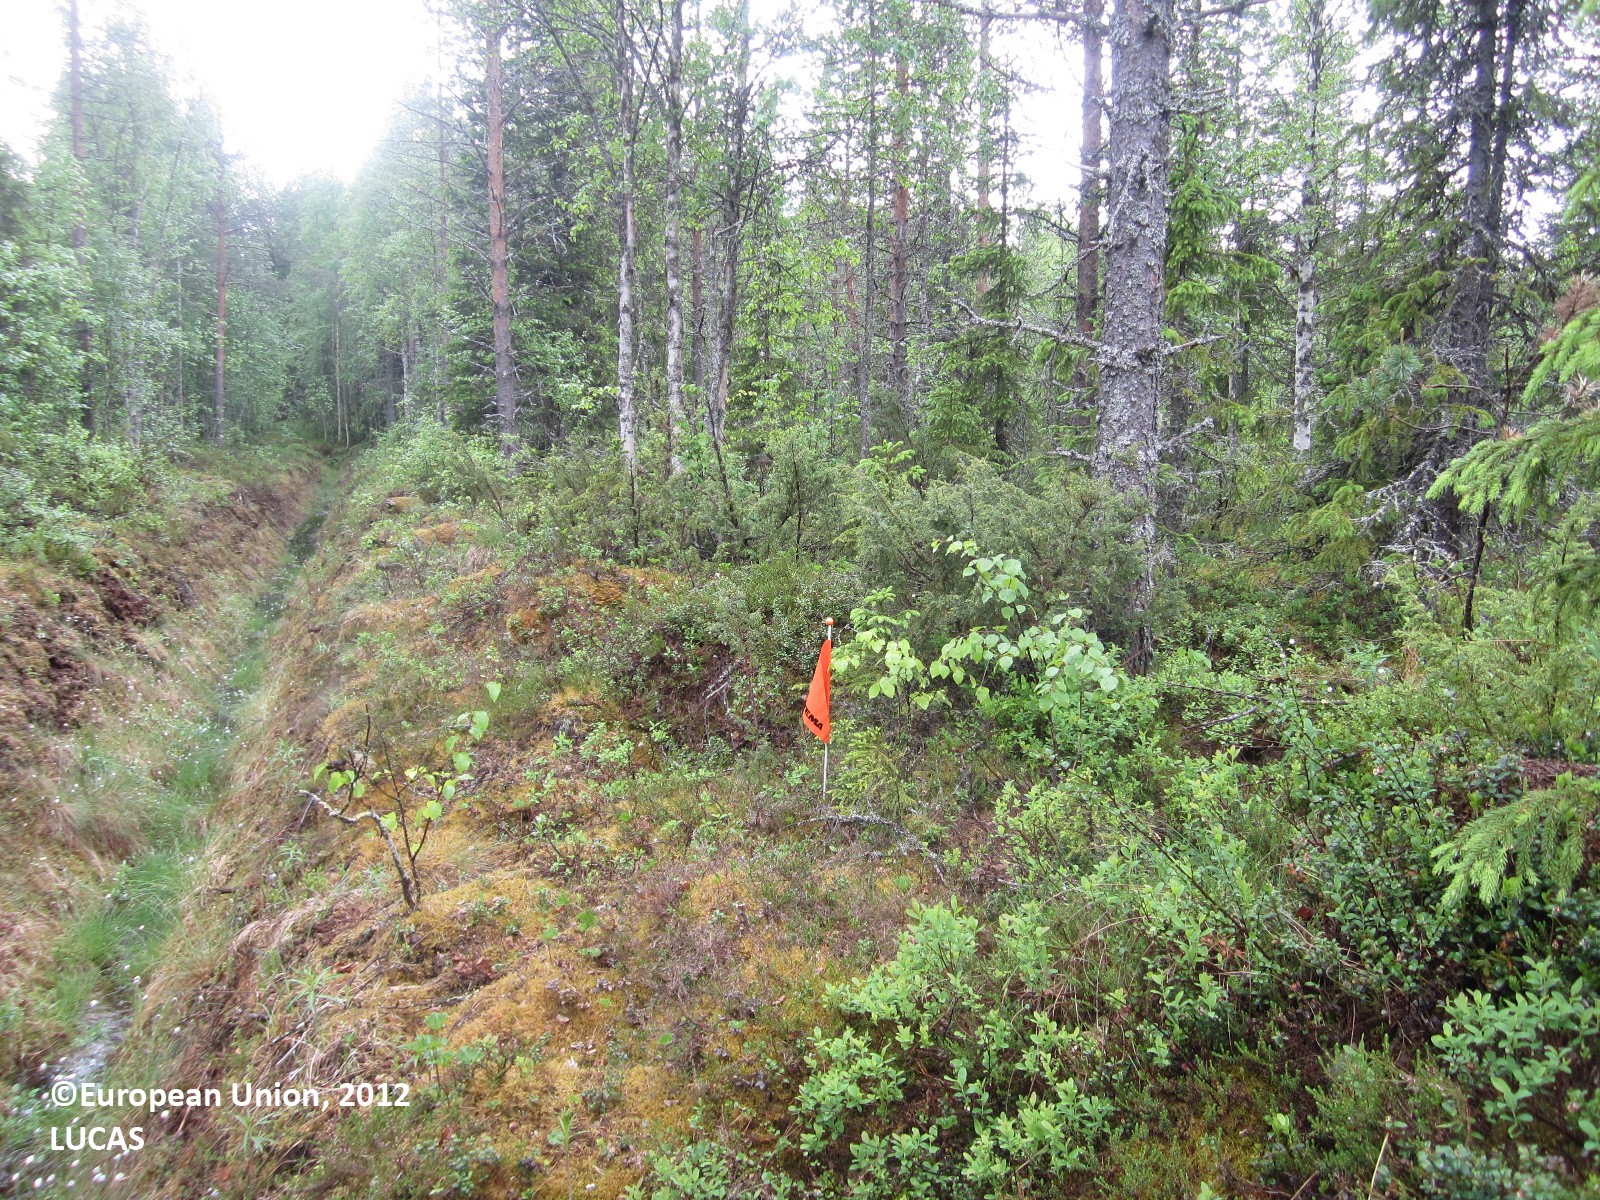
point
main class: Woodland
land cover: Other coniferous woodland
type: boreal forest
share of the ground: > 75 %
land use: Forestry
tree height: > 5 m
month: June
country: FI
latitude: 64.6667
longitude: 29.8080
